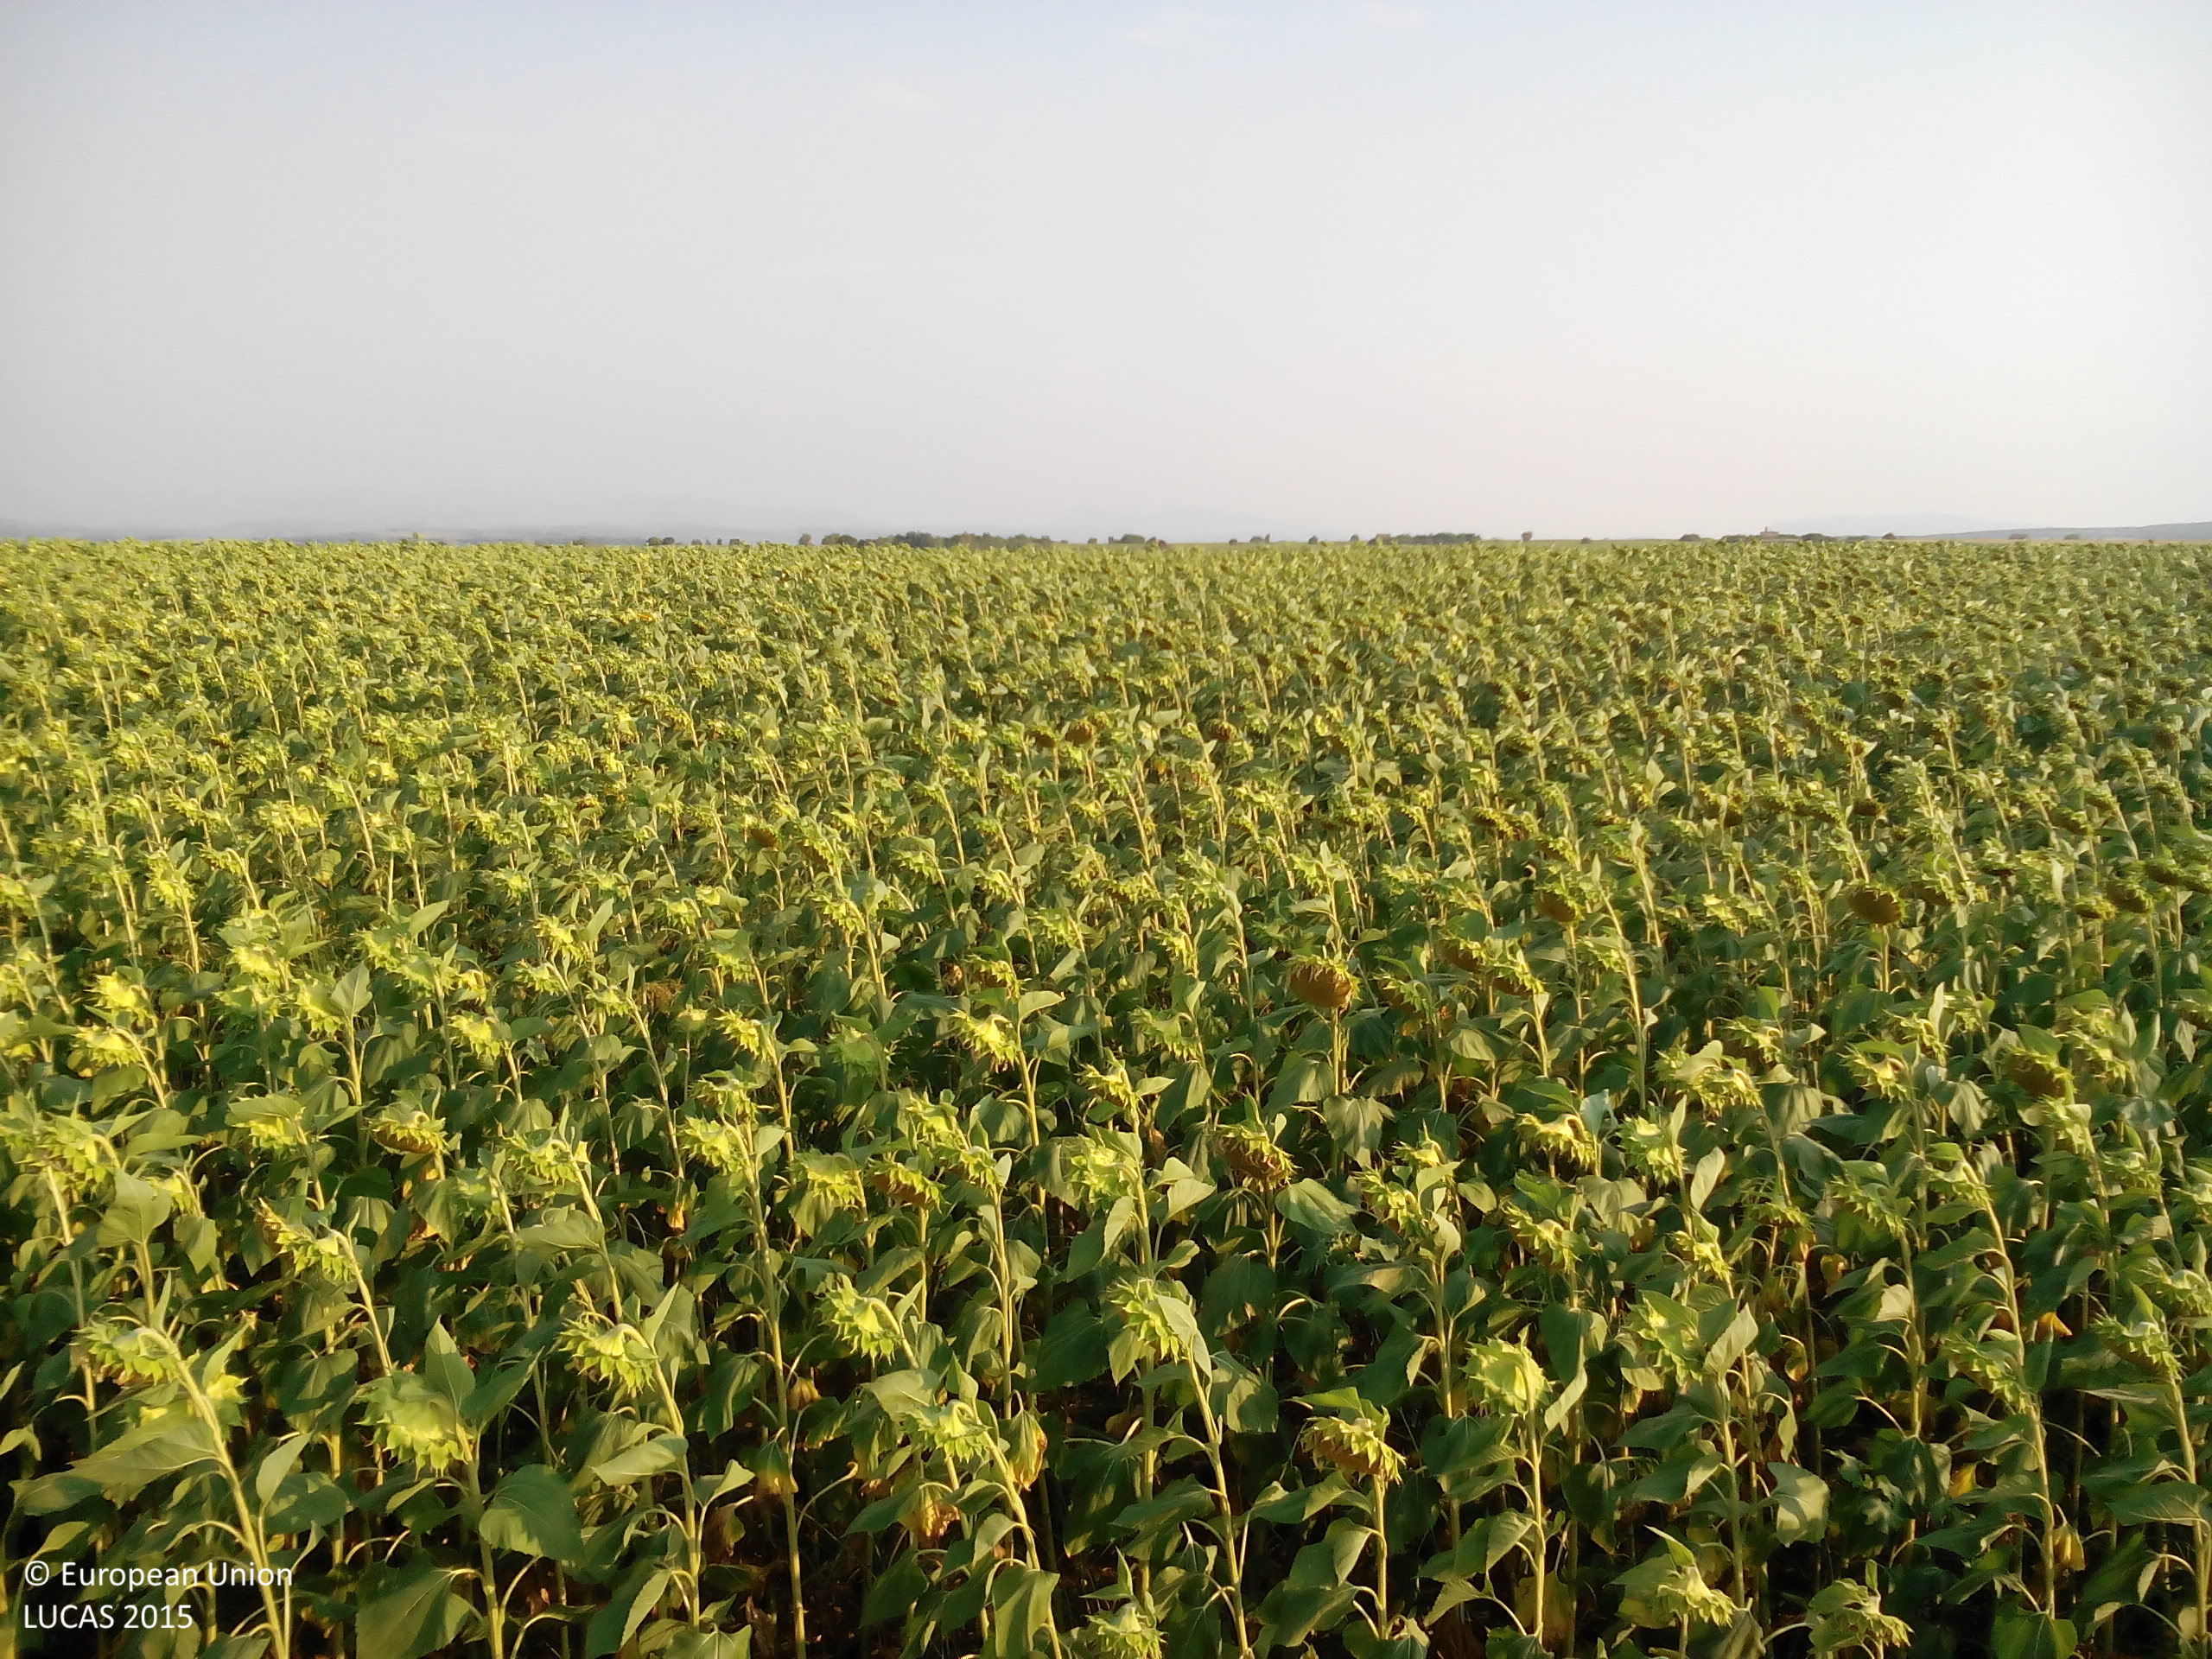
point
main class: Cropland
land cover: Sunflower
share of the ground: > 75 %
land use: Agriculture (excluding fallow land and kitchen gardens)
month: July
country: BG
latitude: 43.2288
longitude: 24.1505
